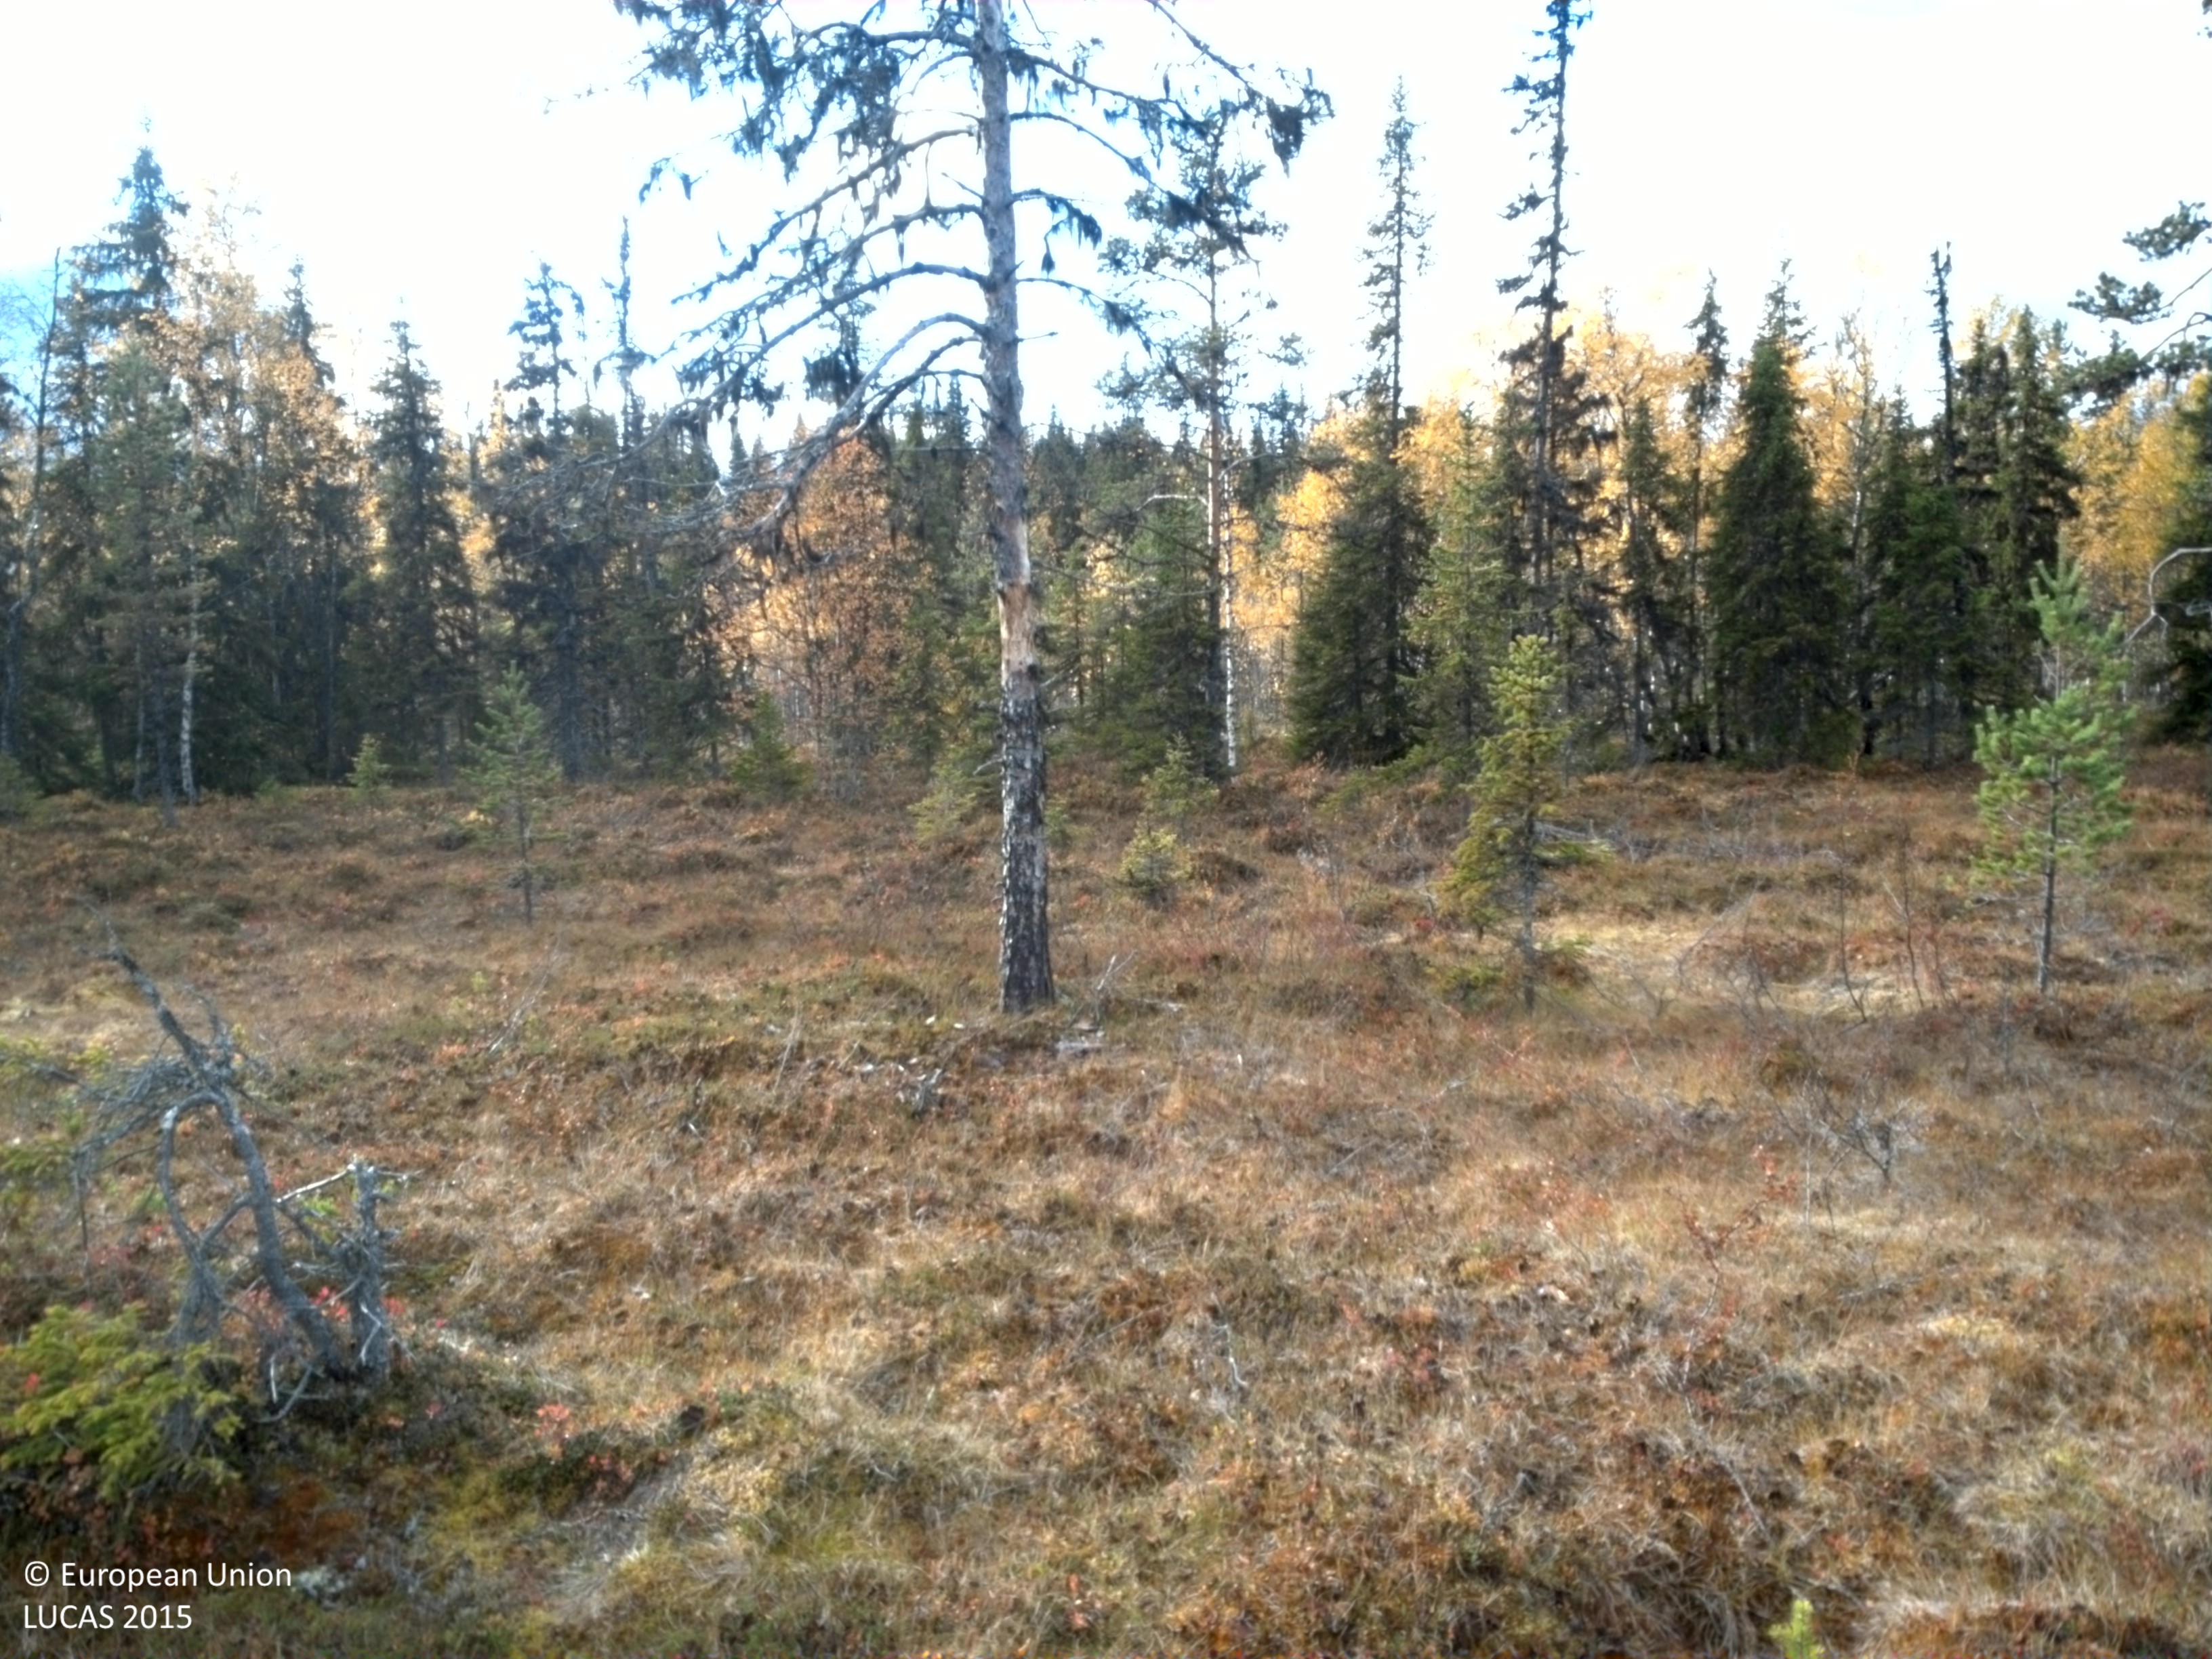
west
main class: Shrubland
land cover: Shrubland with sparse tree cover
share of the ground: 25 - 50 %
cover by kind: lichens and mosses 45 %, shrubs 40 %, herbaceous plants 10 %, coniferous forest trees 5 %
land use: Semi-natural and natural areas not in use
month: September
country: SE
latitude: 65.0296
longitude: 16.8637
